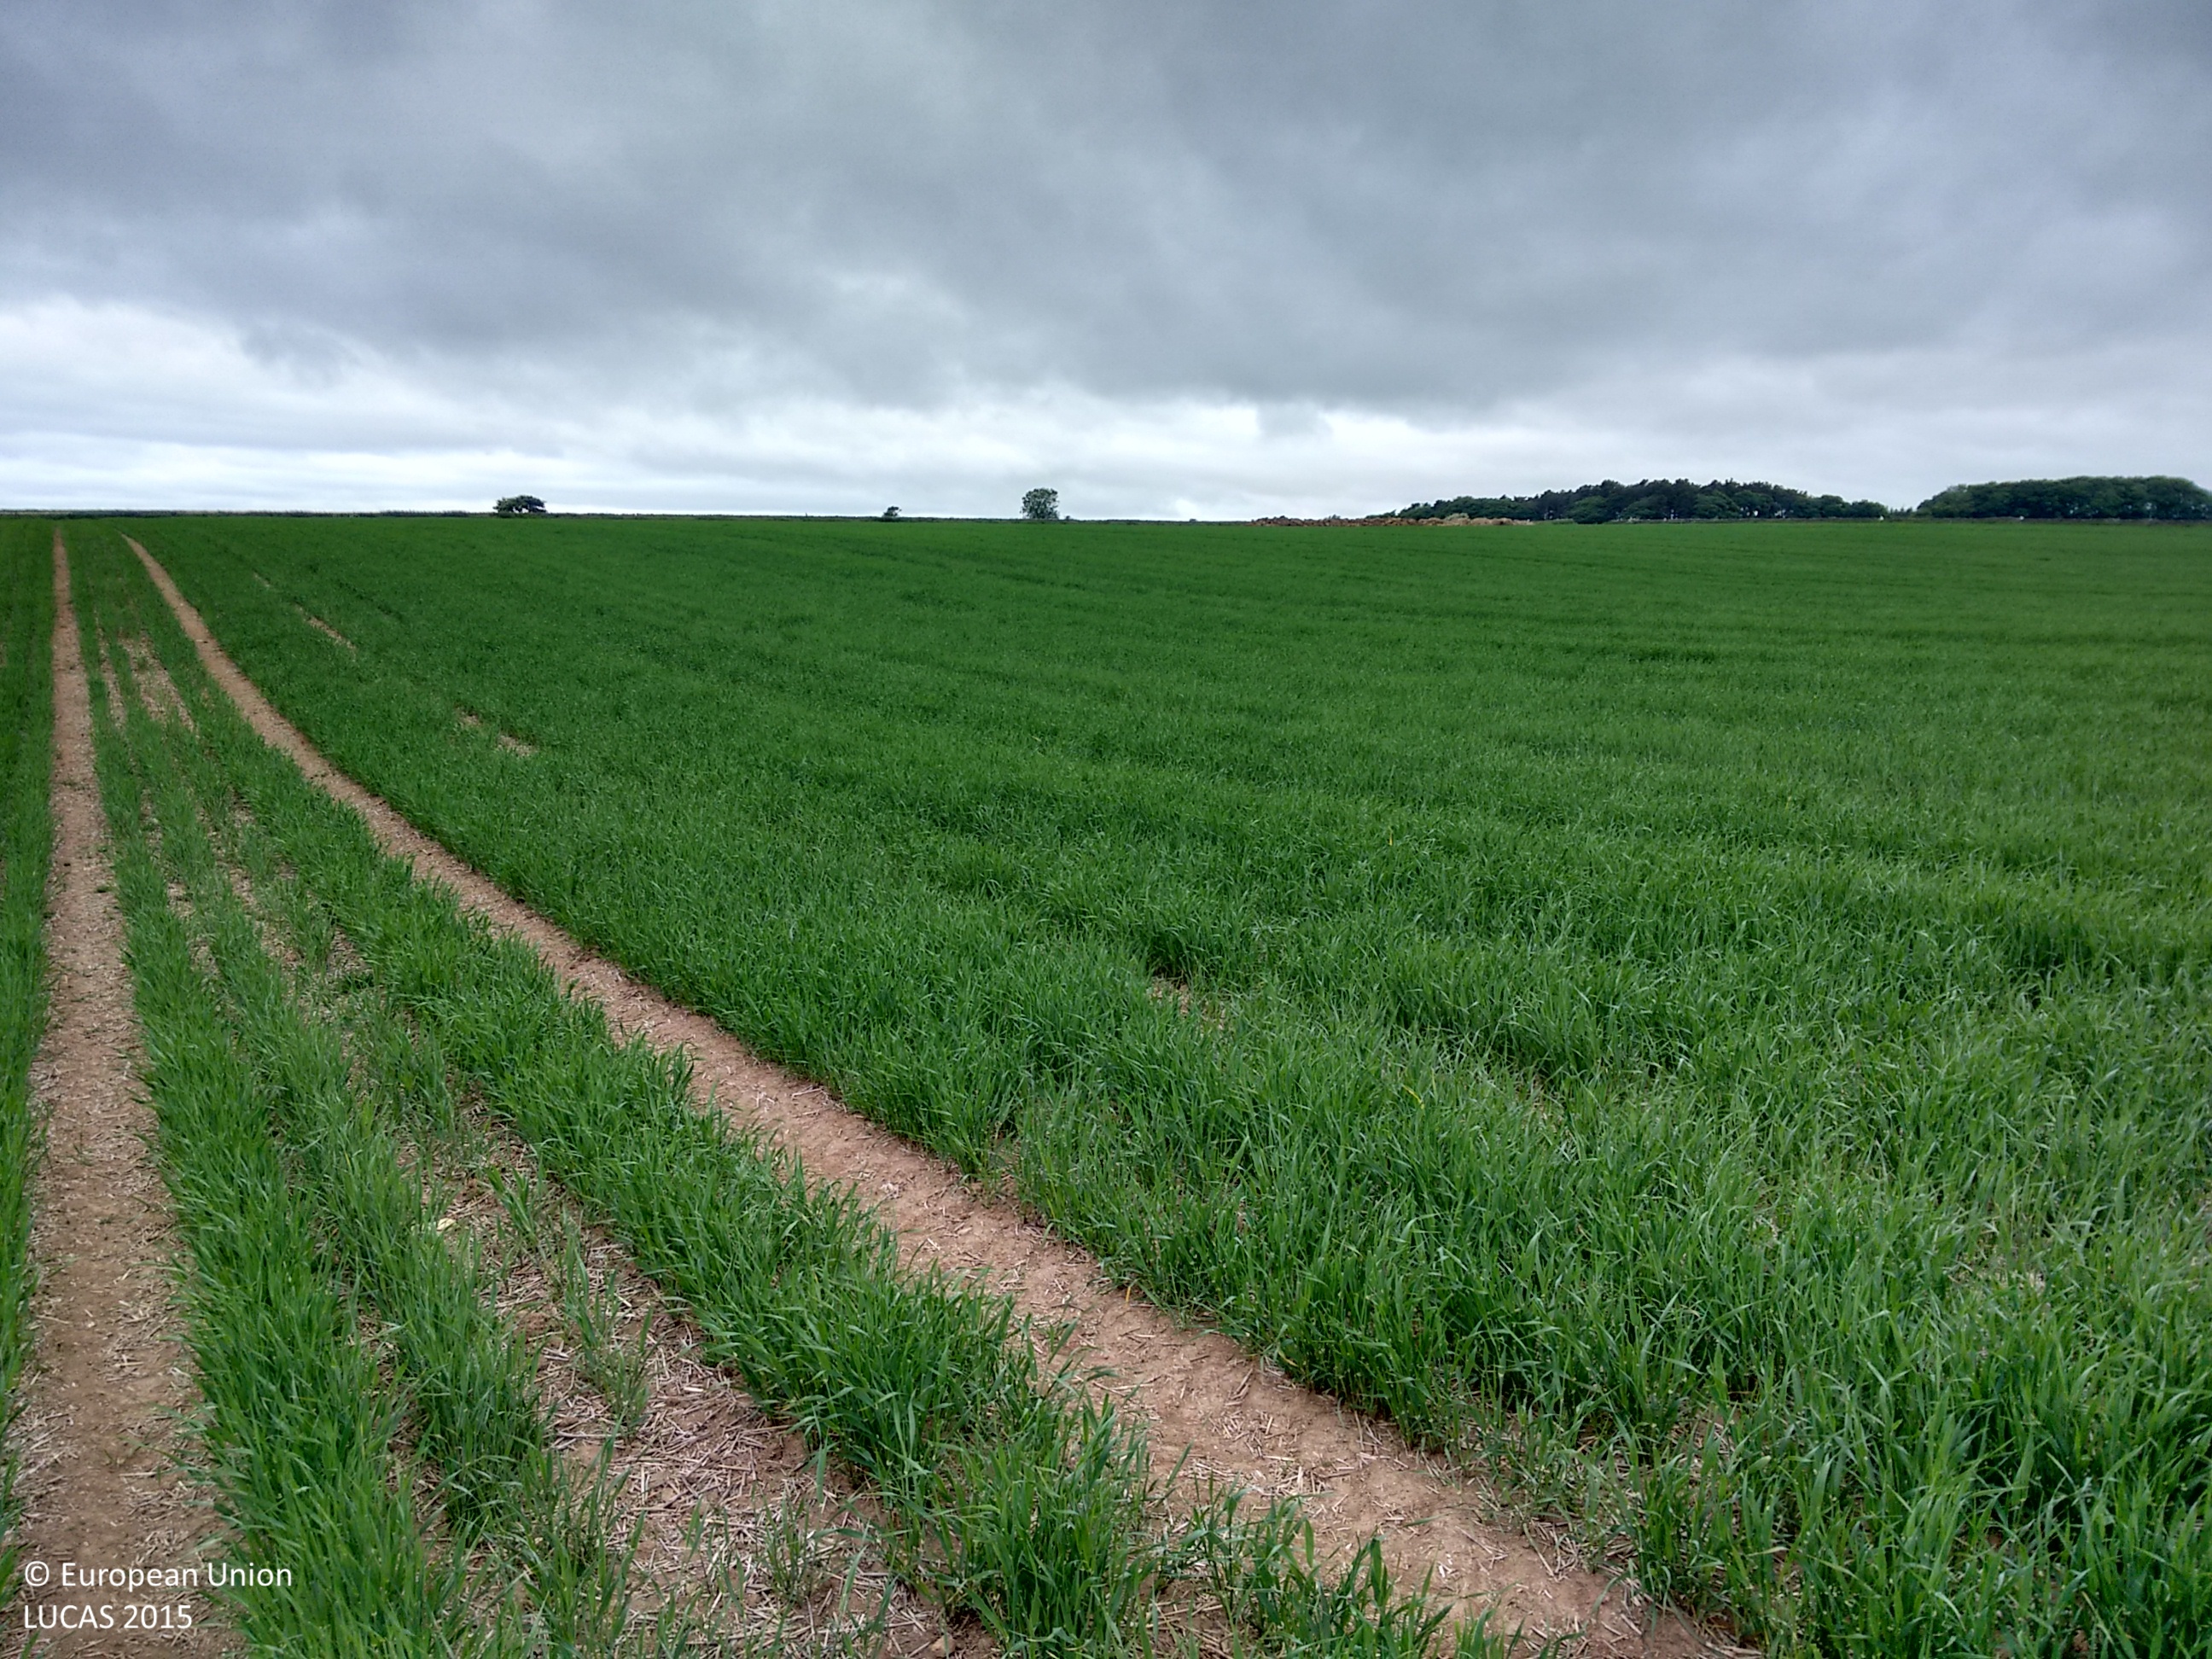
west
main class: Cropland
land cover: Barley
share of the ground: > 75 %
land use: Agriculture (excluding fallow land and kitchen gardens)
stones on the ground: < 10 %
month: June
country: GB
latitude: 54.2779
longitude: -1.2103
